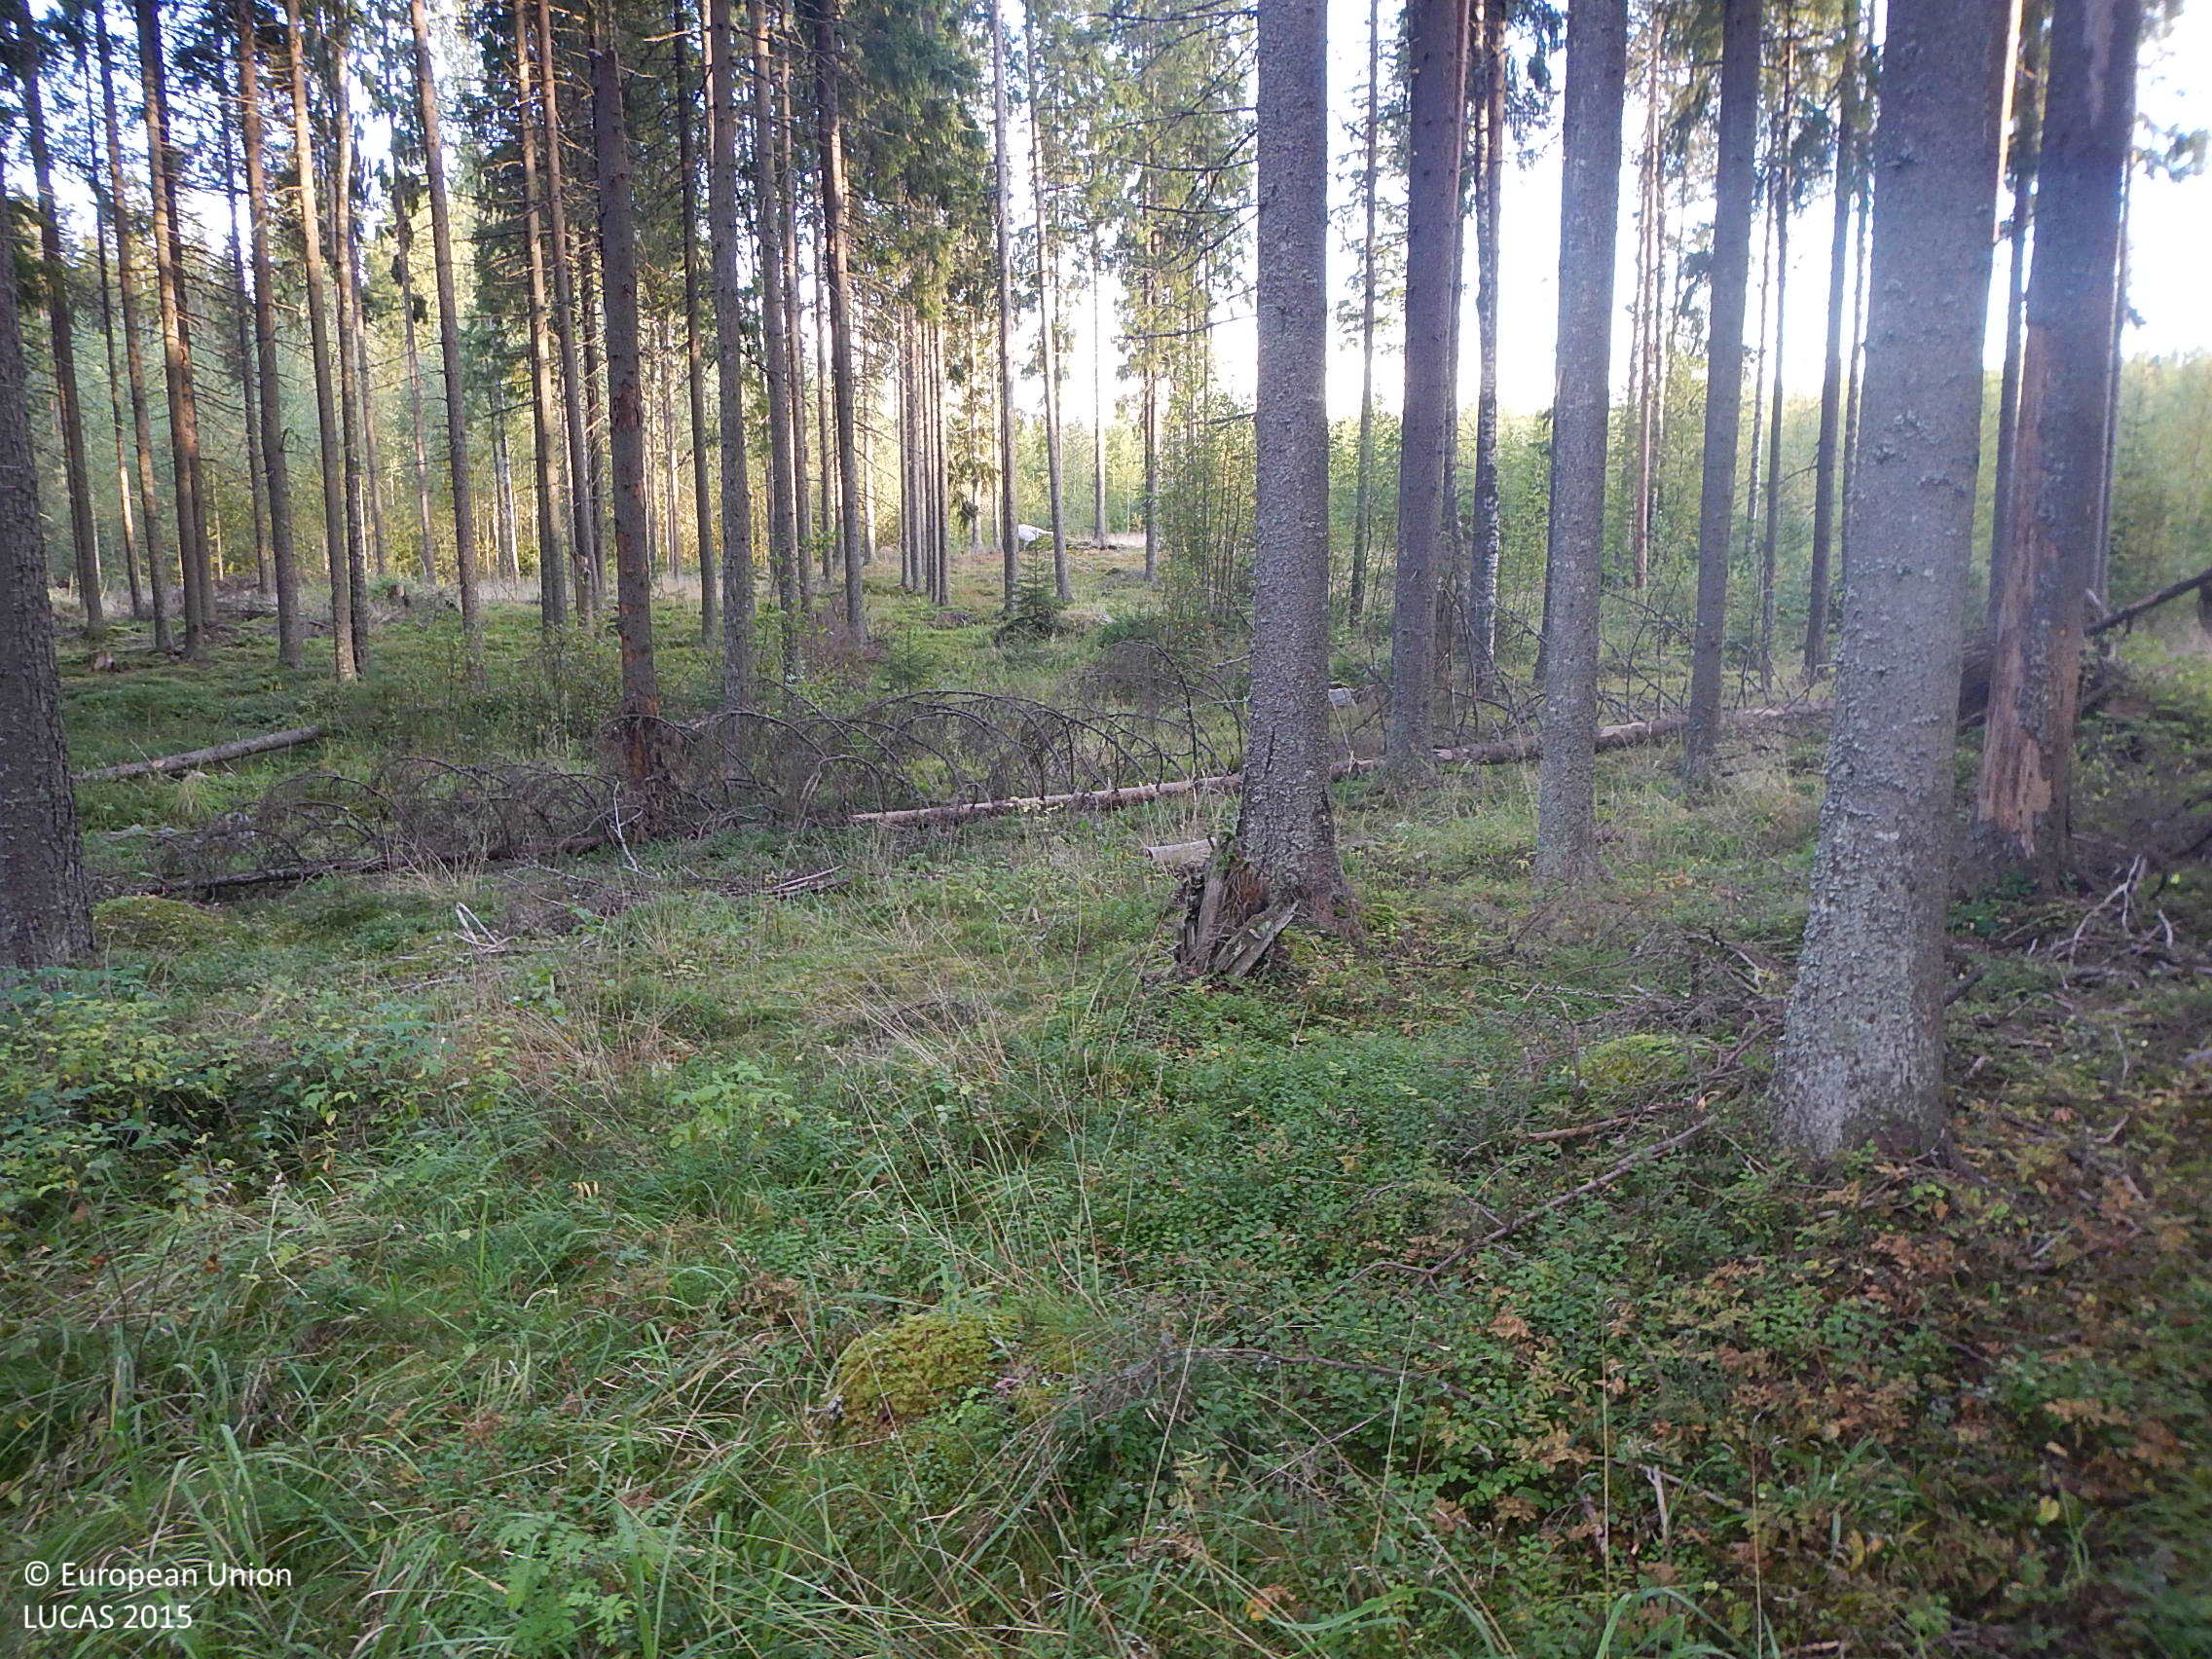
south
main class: Woodland
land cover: Spruce dominated coniferous woodland
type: boreal forest
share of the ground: > 75 %
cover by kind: coniferous forest trees 80 %, shrubs 10 %, herbaceous plants 10 %
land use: Forestry
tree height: > 5 m
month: September
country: FI
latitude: 61.5246
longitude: 22.6818
